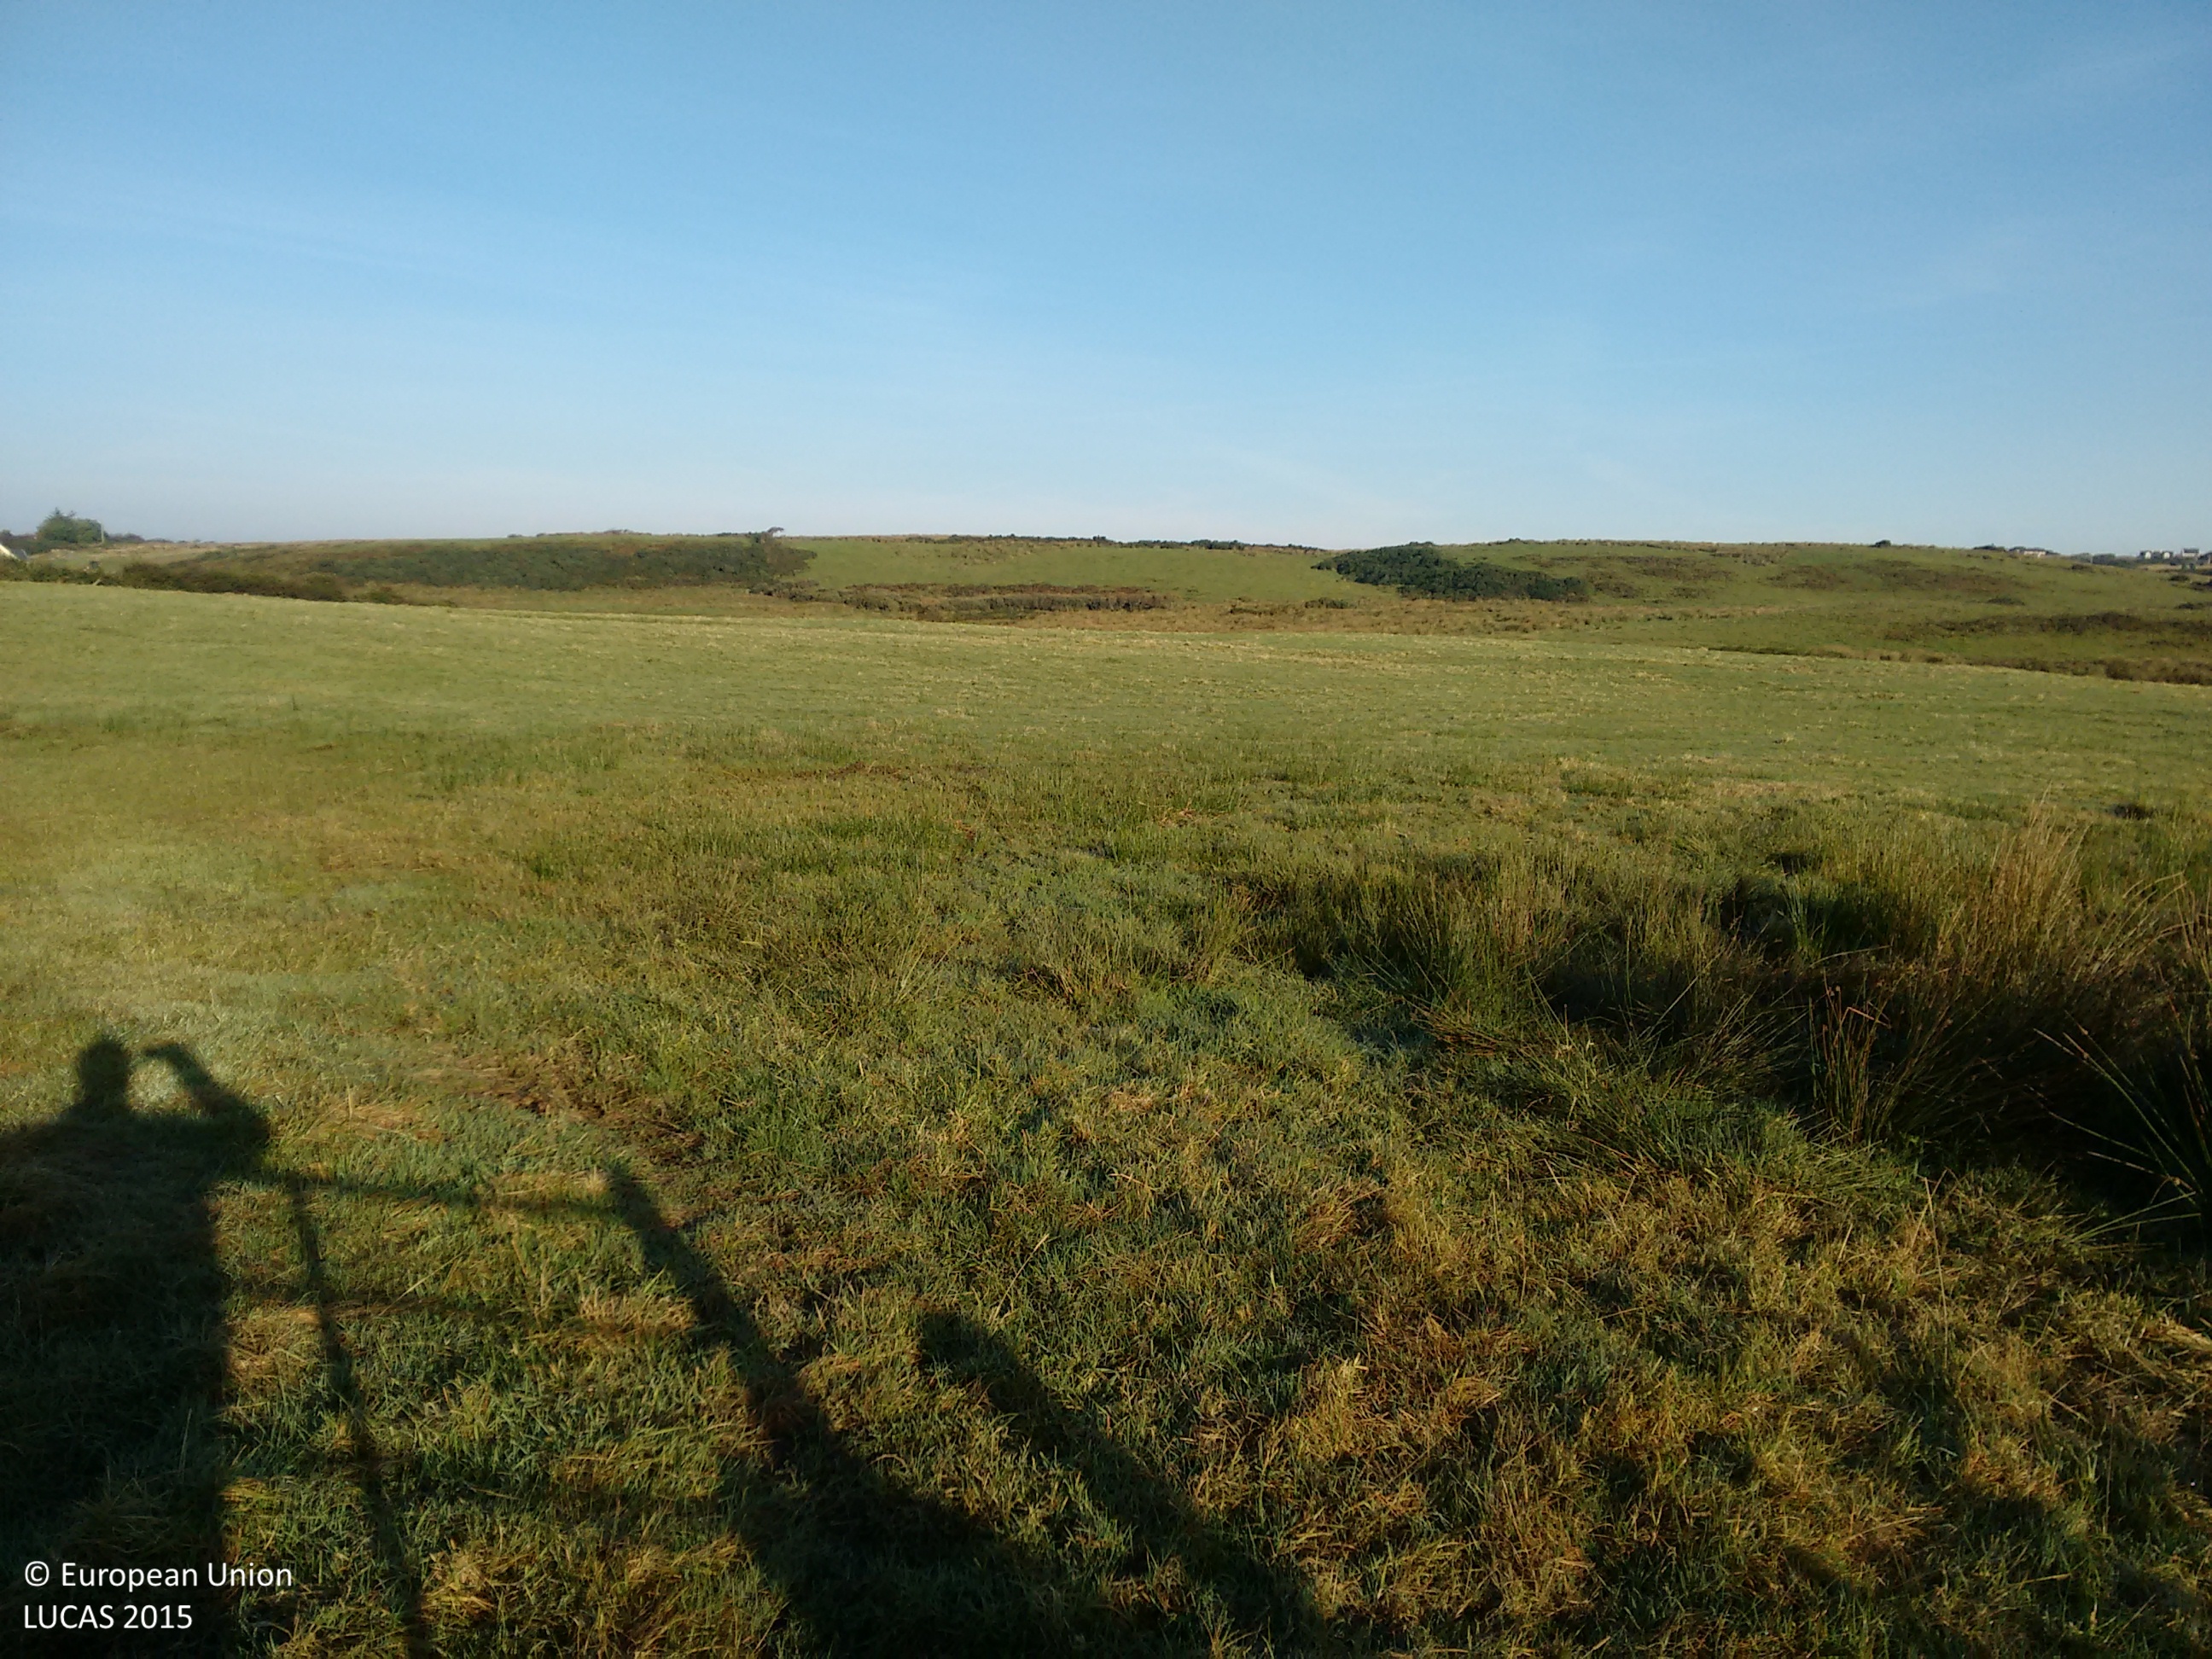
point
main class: Grassland
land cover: Grassland without tree/shrub cover
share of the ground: > 75 %
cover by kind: herbaceous plants 100 %
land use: Agriculture (excluding fallow land and kitchen gardens)
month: September
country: IE
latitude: 53.0266
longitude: -9.3252
